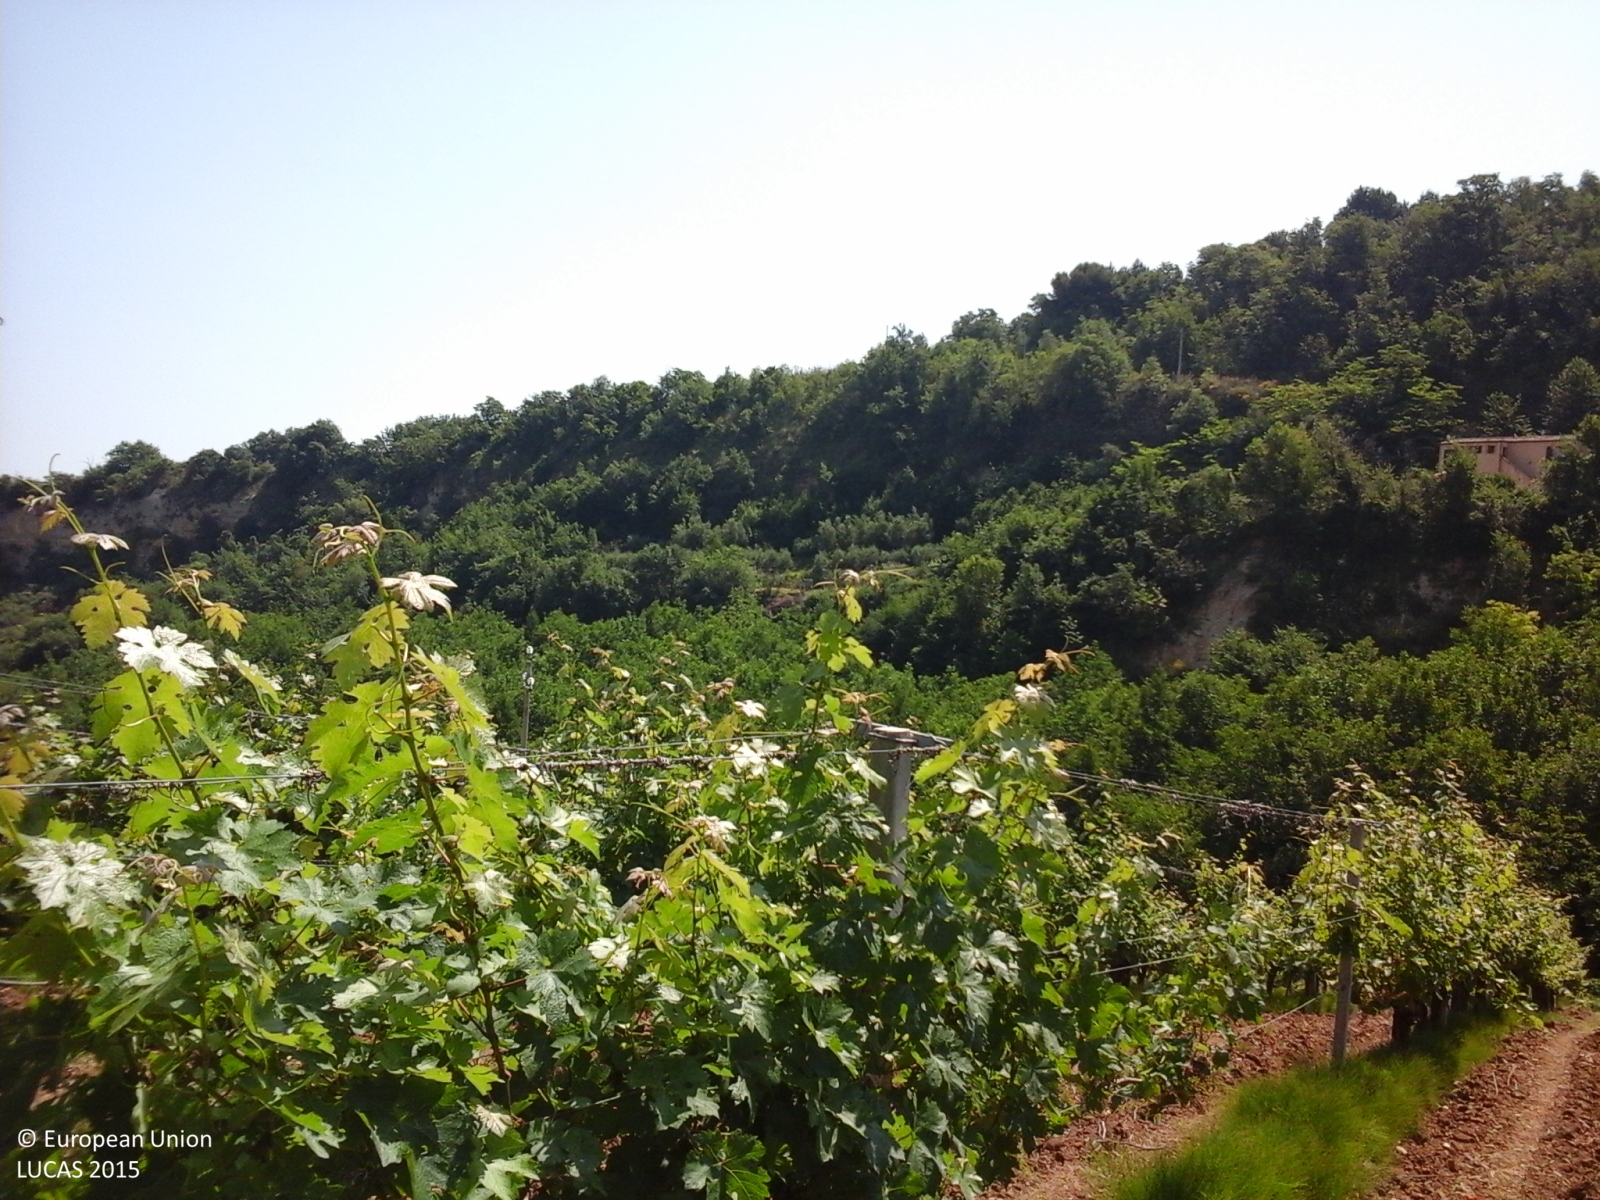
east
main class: Cropland
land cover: Vineyards
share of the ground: 50 - 75 %
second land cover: Other bare soil
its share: > 75 %
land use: Agriculture (excluding fallow land and kitchen gardens)
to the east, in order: Vineyards; Other bare soil; Electric lines; Grass margins; Ditches and canals; Spontaneously vegetated surfaces; Abandoned hedges; Ditches and canals; Nuts trees; Broadleaved woodland; Olive groves; Broadleaved woodland
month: June
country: IT
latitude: 42.9992
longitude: 13.7802
